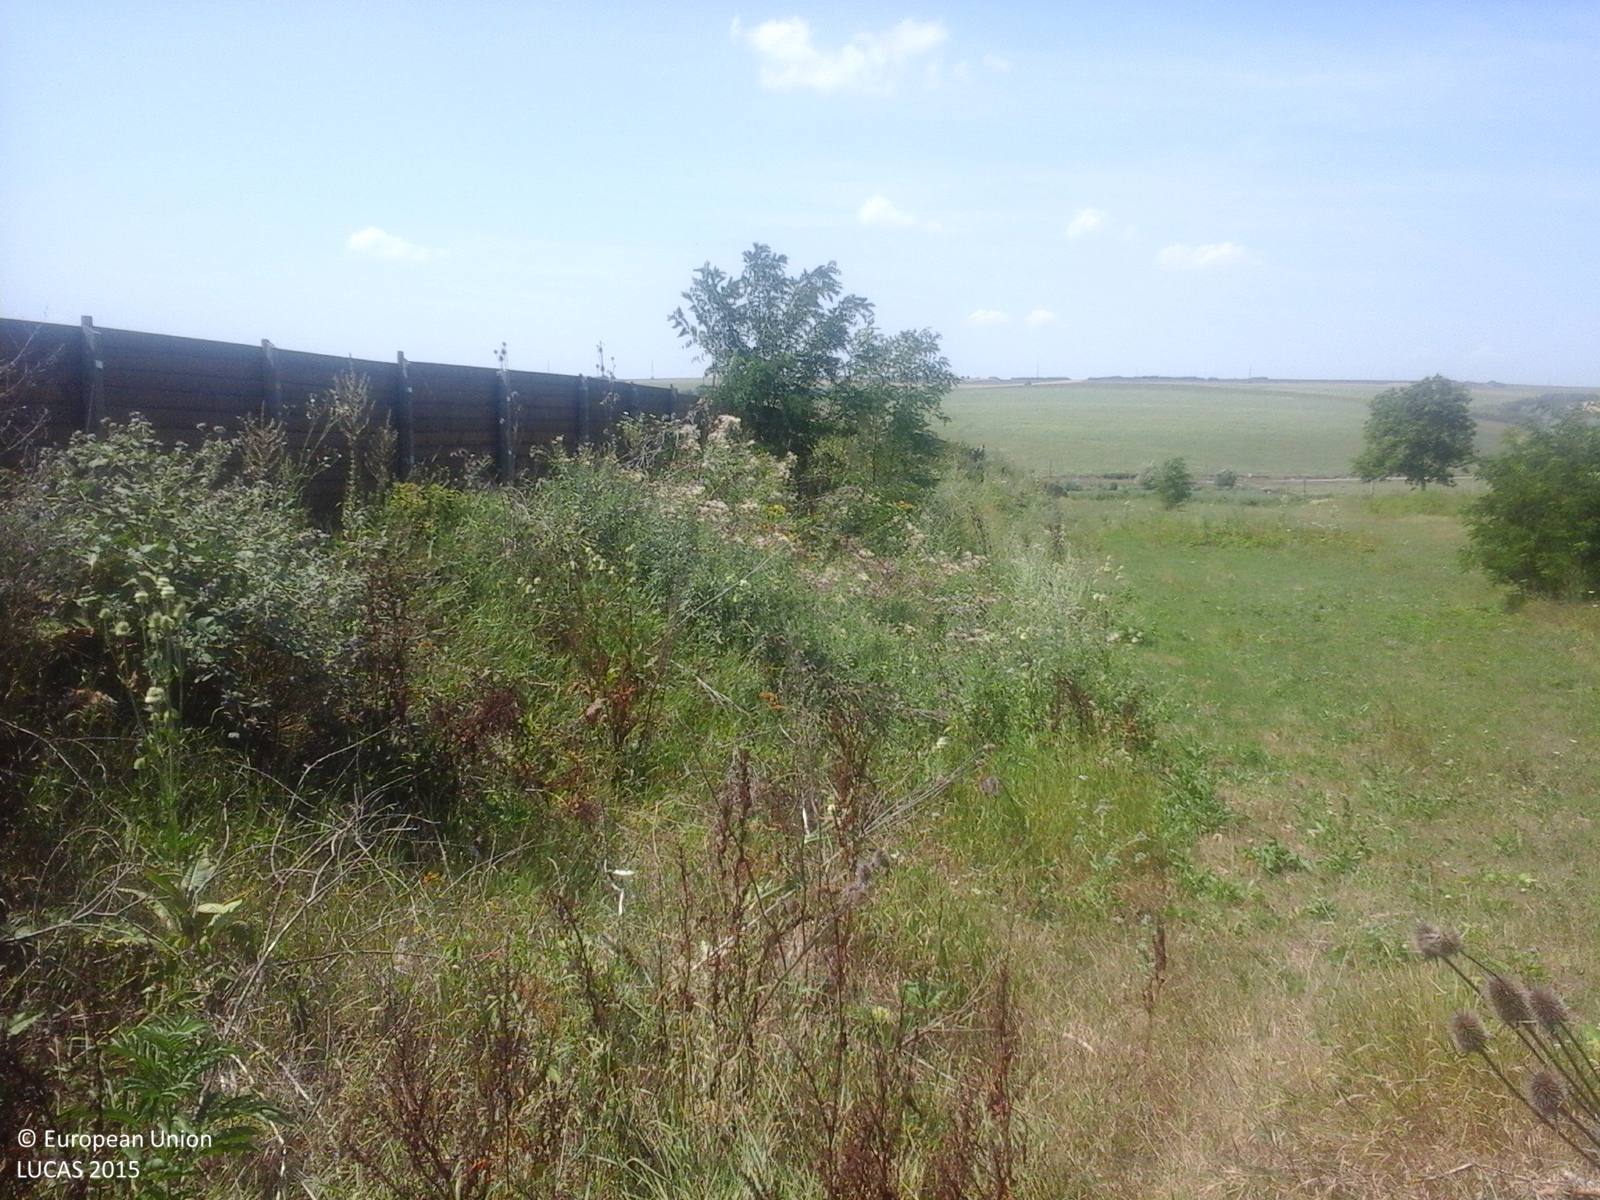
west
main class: Woodland
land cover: Broadleaved woodland
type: broadleaved evergreen forest
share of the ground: > 75 %
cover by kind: broadleaved forest trees 100 %
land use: Forestry
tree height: > 5 m
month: July
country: RO
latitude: 46.6532
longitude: 27.9899
